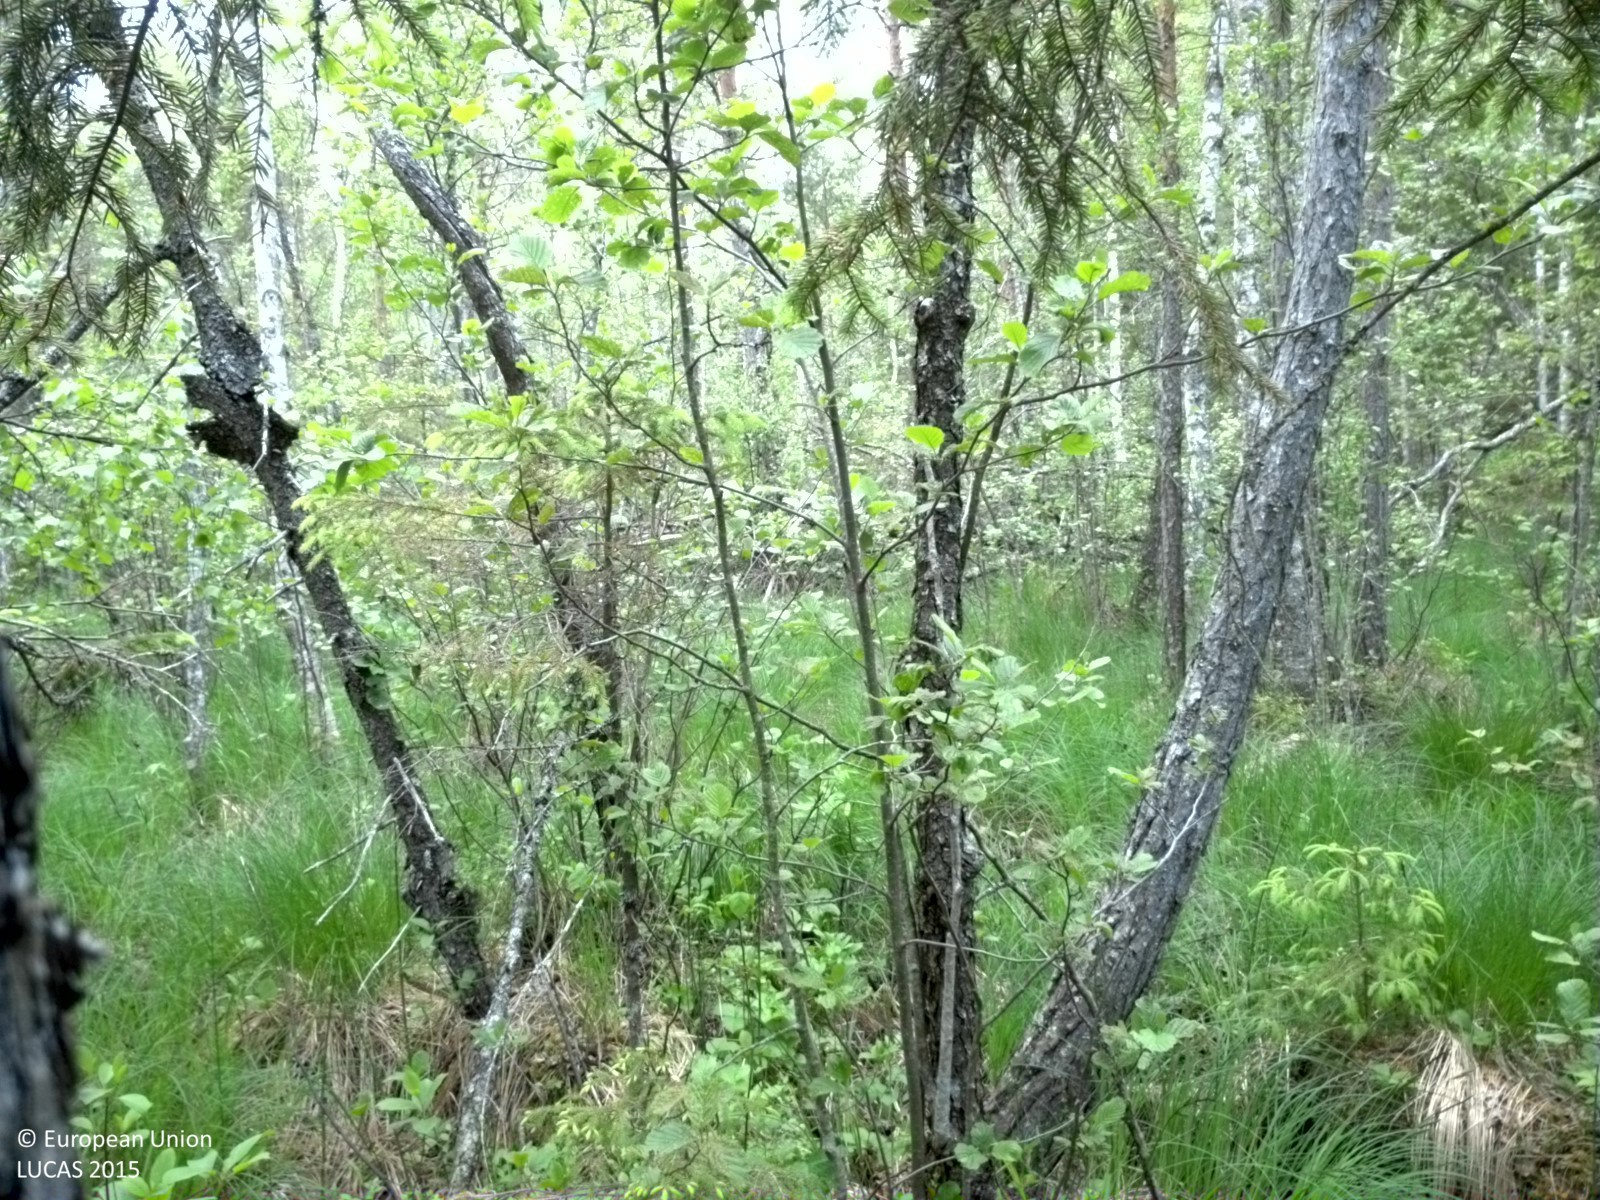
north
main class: Woodland
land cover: Other mixed woodland
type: boreal forest
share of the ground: 50 - 75 %
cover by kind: broadleaved forest trees 35 %, herbaceous plants 30 %, coniferous forest trees 25 %, lichens and mosses 5 %, consolidated bare surface 5 %
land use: Semi-natural and natural areas not in use
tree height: > 5 m
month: June
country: SE
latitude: 60.2692
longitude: 17.8569
